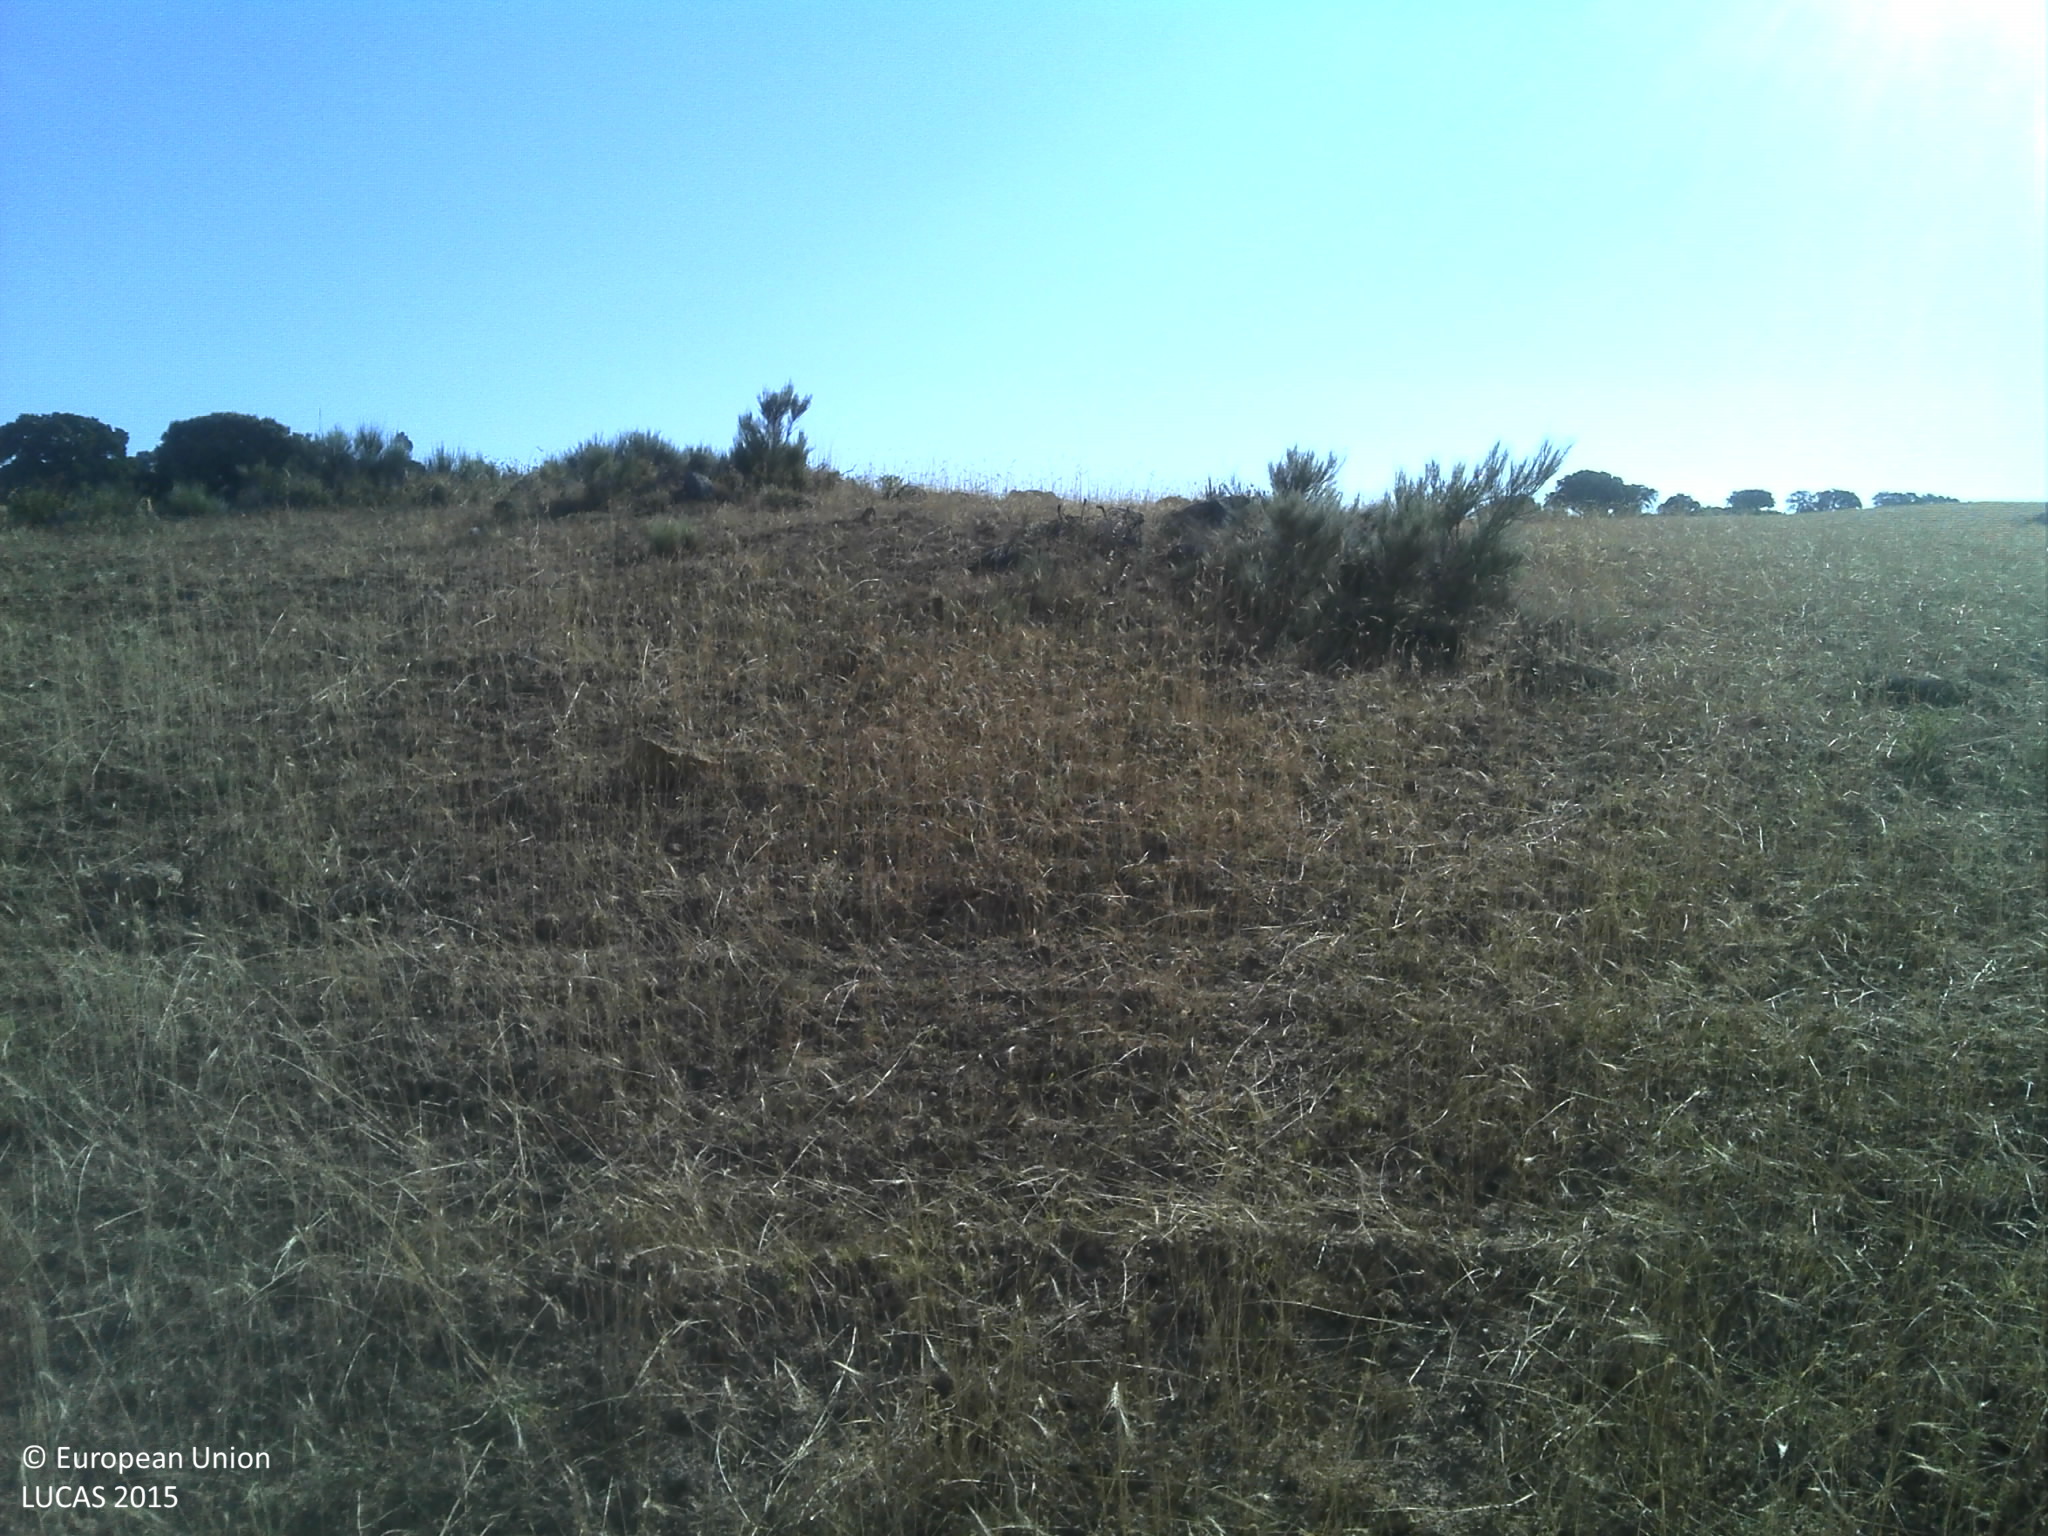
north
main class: Grassland
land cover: Grassland with sparse tree/shrub cover
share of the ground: 25 - 50 %
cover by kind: herbaceous plants 45 %, unconsolidated bare surface 40 %, shrubs 10 %, broadleaved forest trees 5 %
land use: Agriculture (excluding fallow land and kitchen gardens)
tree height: < 5 m
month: June
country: PT
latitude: 40.0821
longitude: -7.3030
